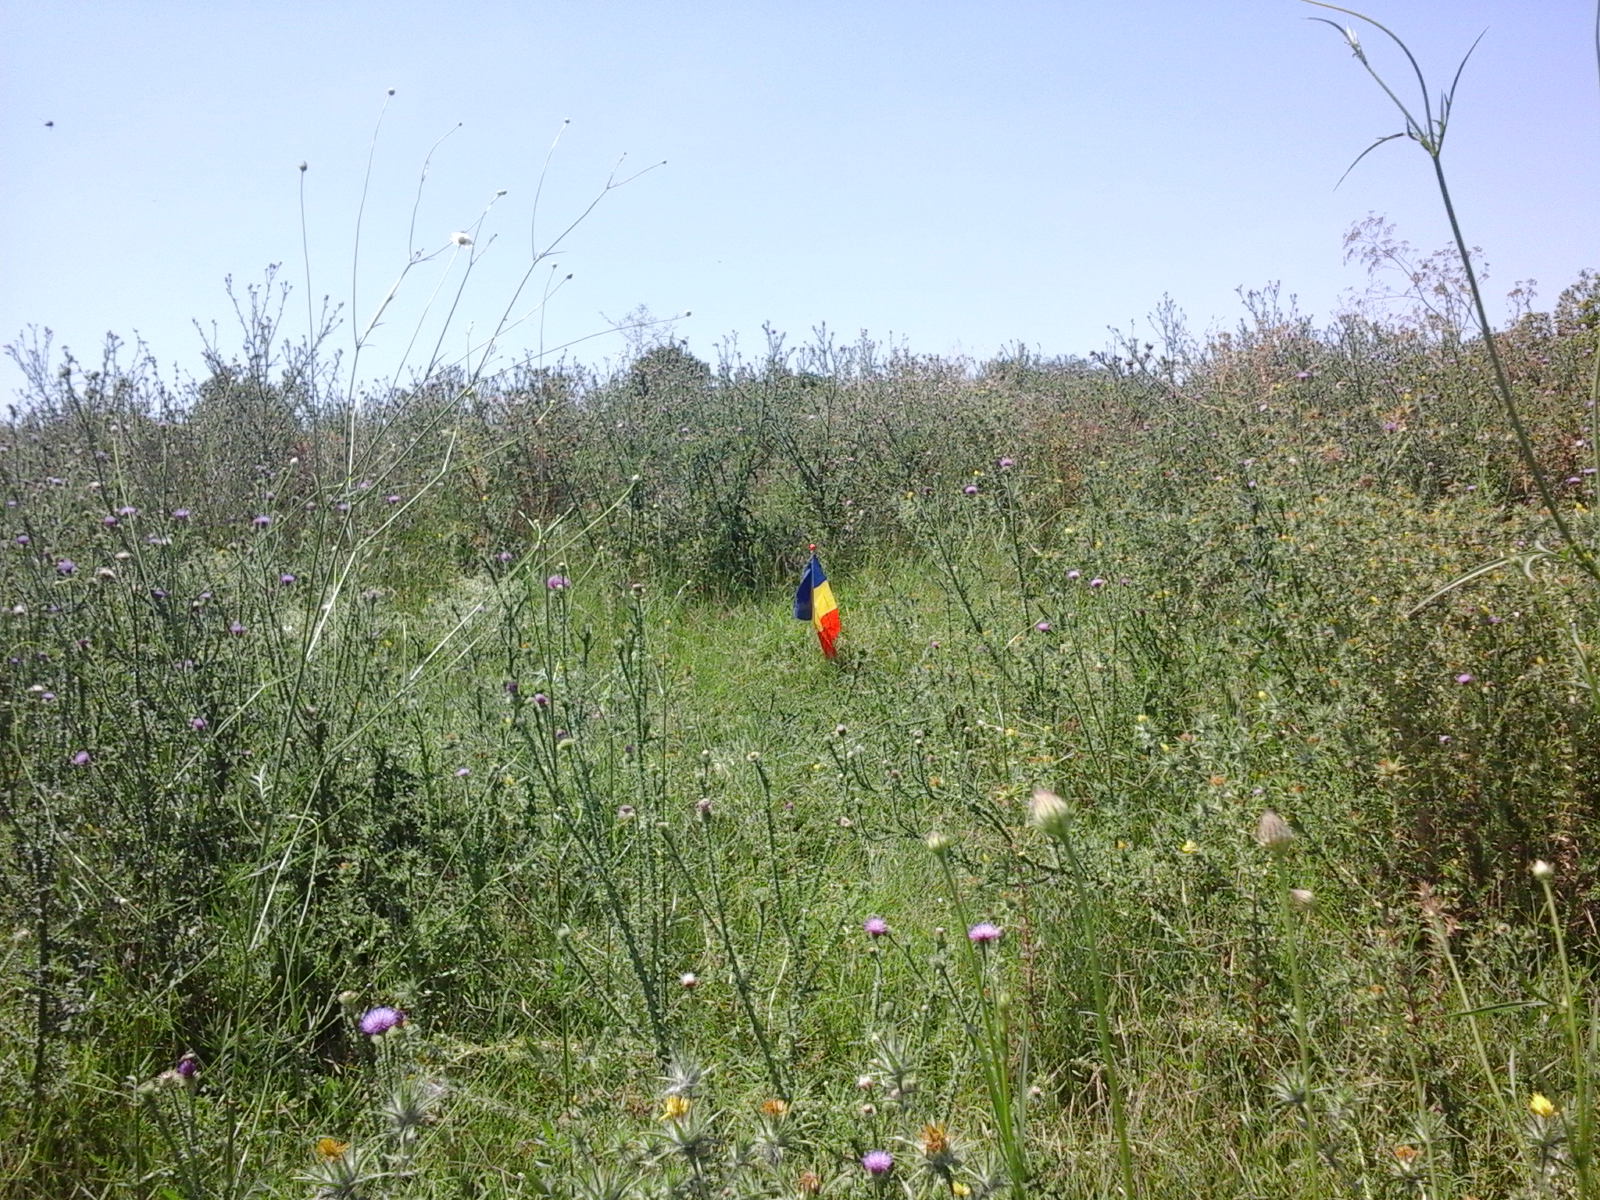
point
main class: Grassland
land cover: Spontaneously vegetated surfaces
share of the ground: > 75 %
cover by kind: herbaceous plants 100 %
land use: Semi-natural and natural areas not in use
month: July
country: RO
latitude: 44.3428
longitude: 26.3797
